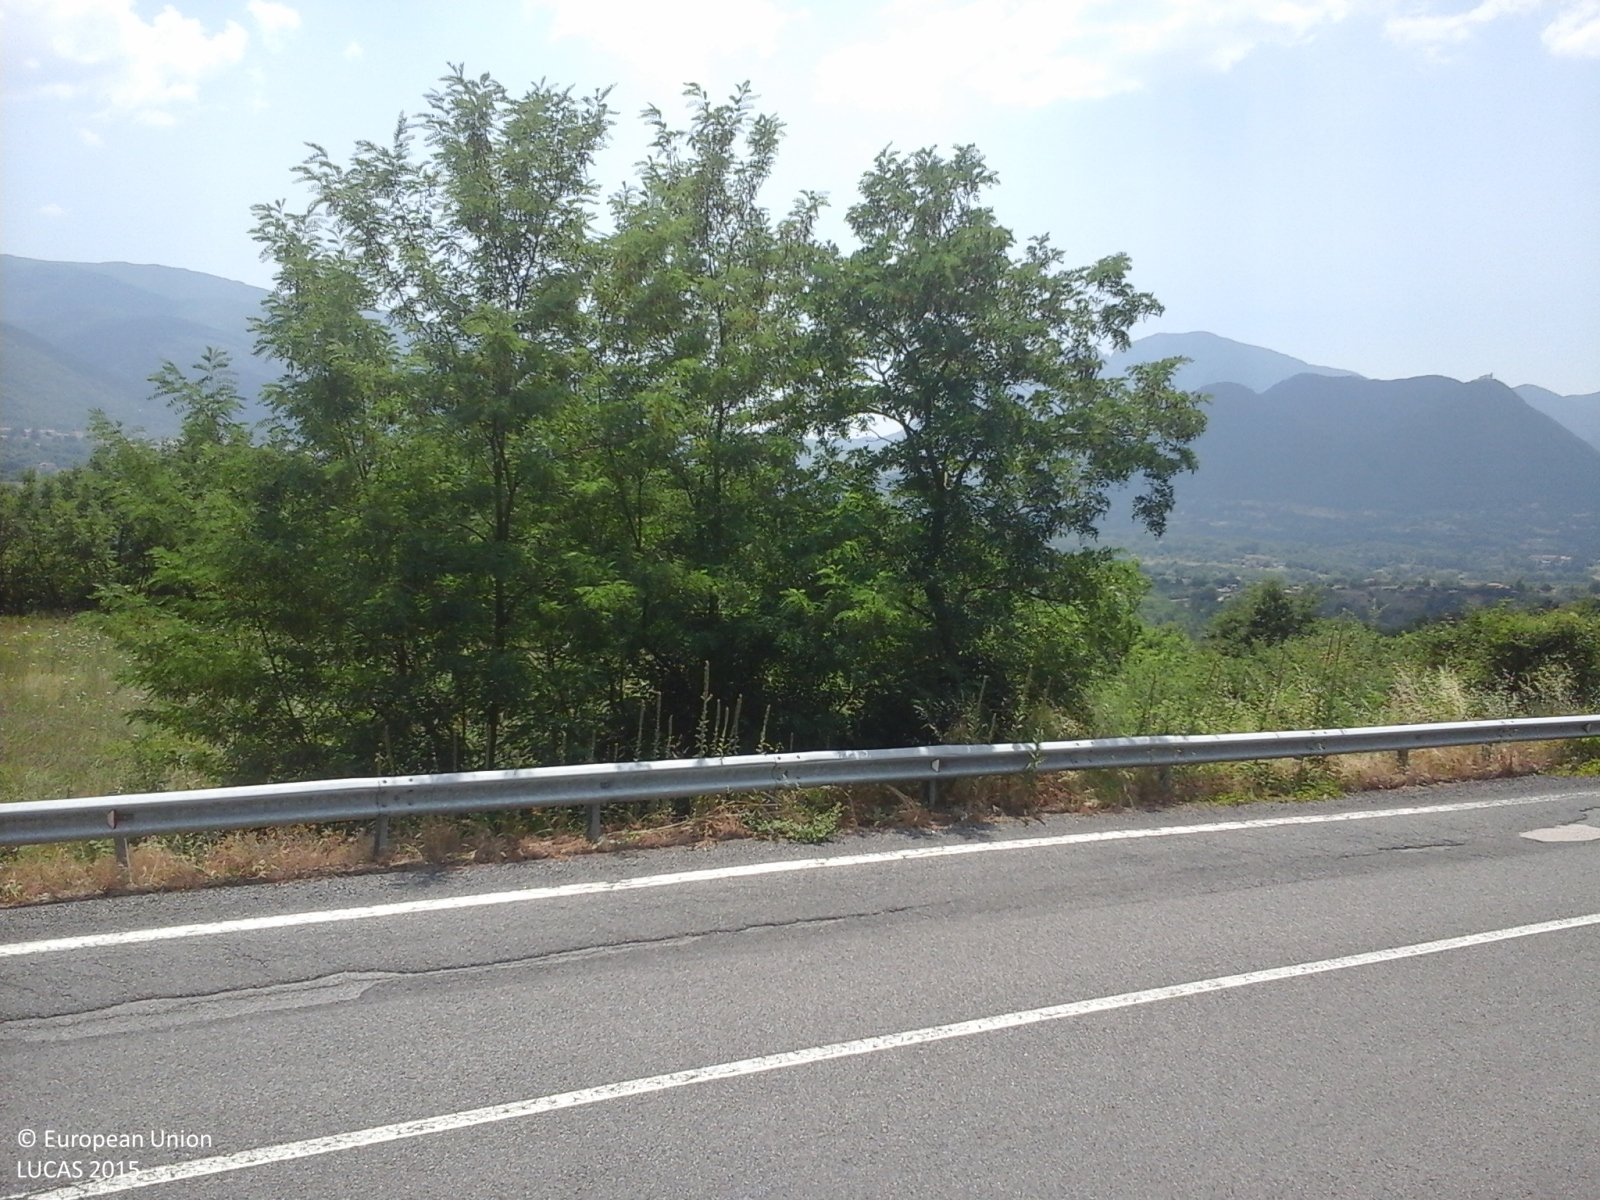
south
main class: Woodland
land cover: Broadleaved woodland
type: thermophilous deciduous forest
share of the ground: > 75 %
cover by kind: broadleaved forest trees 80 %, shrubs 15 %, herbaceous plants 5 %
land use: Forestry
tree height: > 5 m
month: July
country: IT
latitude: 40.8613
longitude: 15.0696
